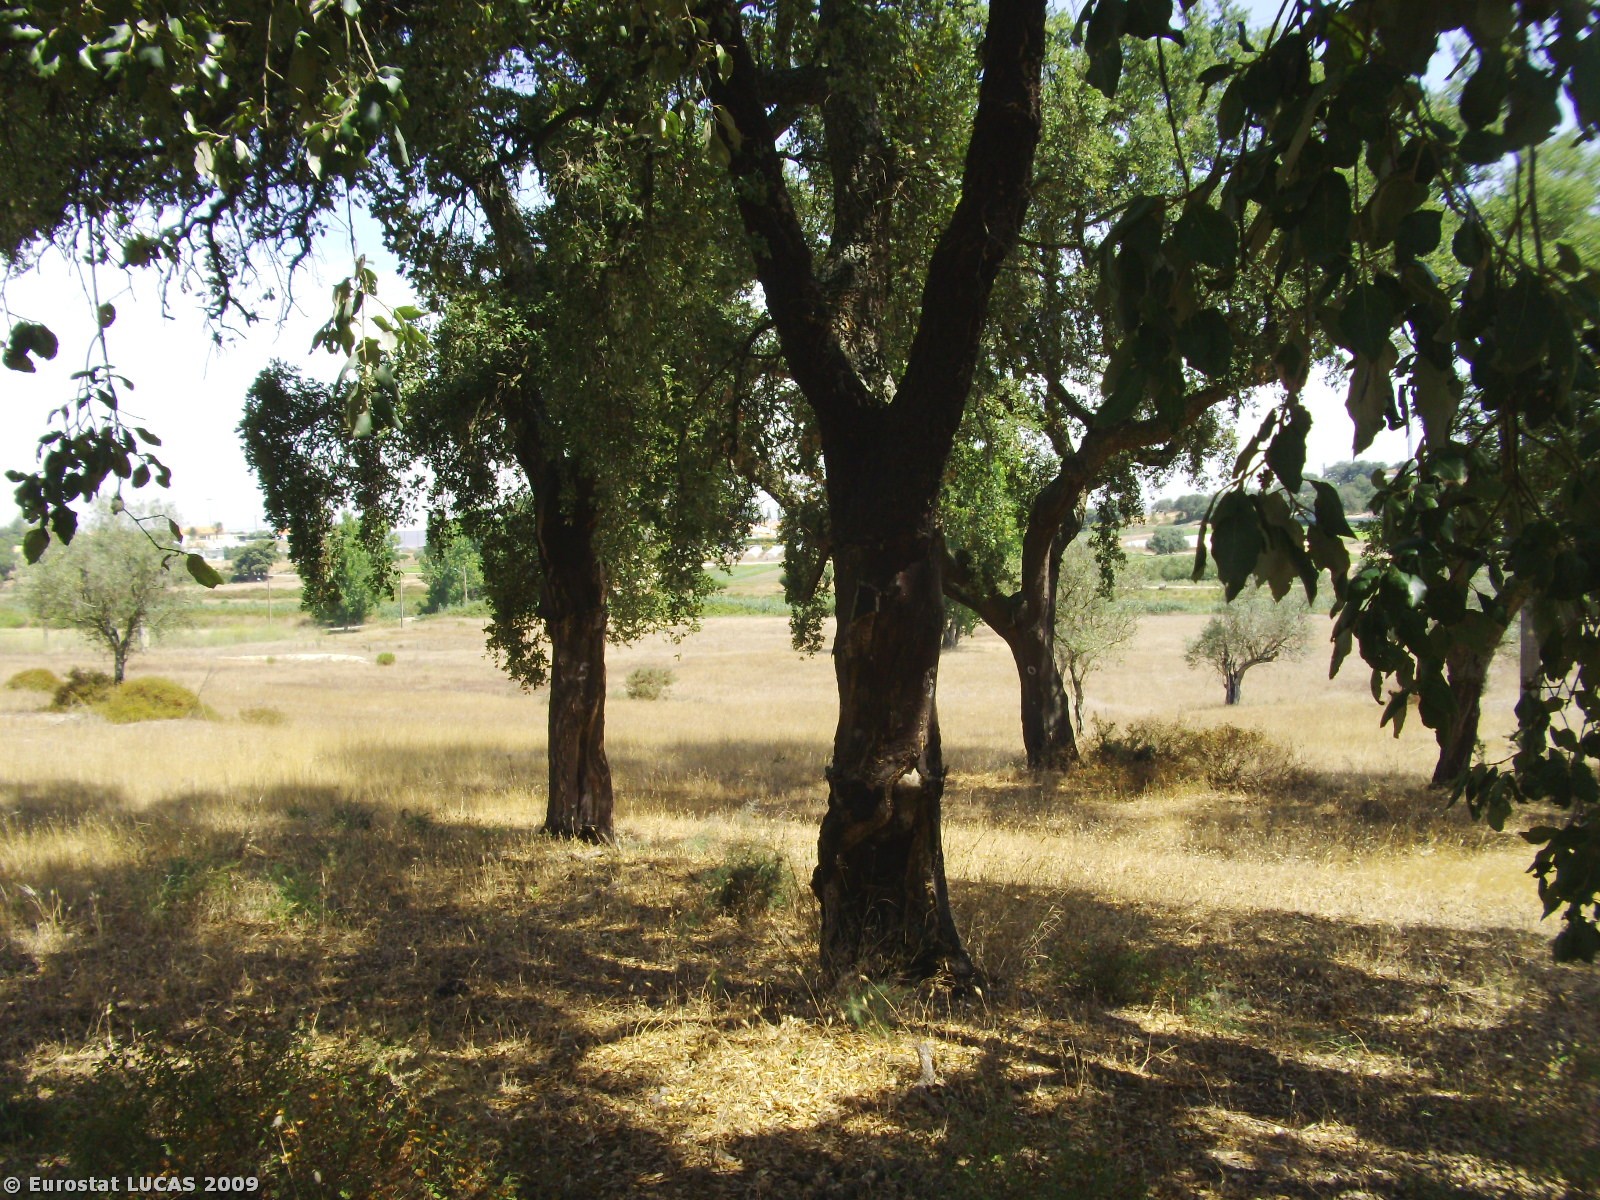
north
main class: Woodland
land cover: Broadleaved woodland
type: broadleaved evergreen forest
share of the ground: 25 - 50 %
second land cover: Bare land
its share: > 75 %
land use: Forestry
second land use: Fallow land
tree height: > 5 m
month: July
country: PT
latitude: 38.5384
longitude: -8.8200
